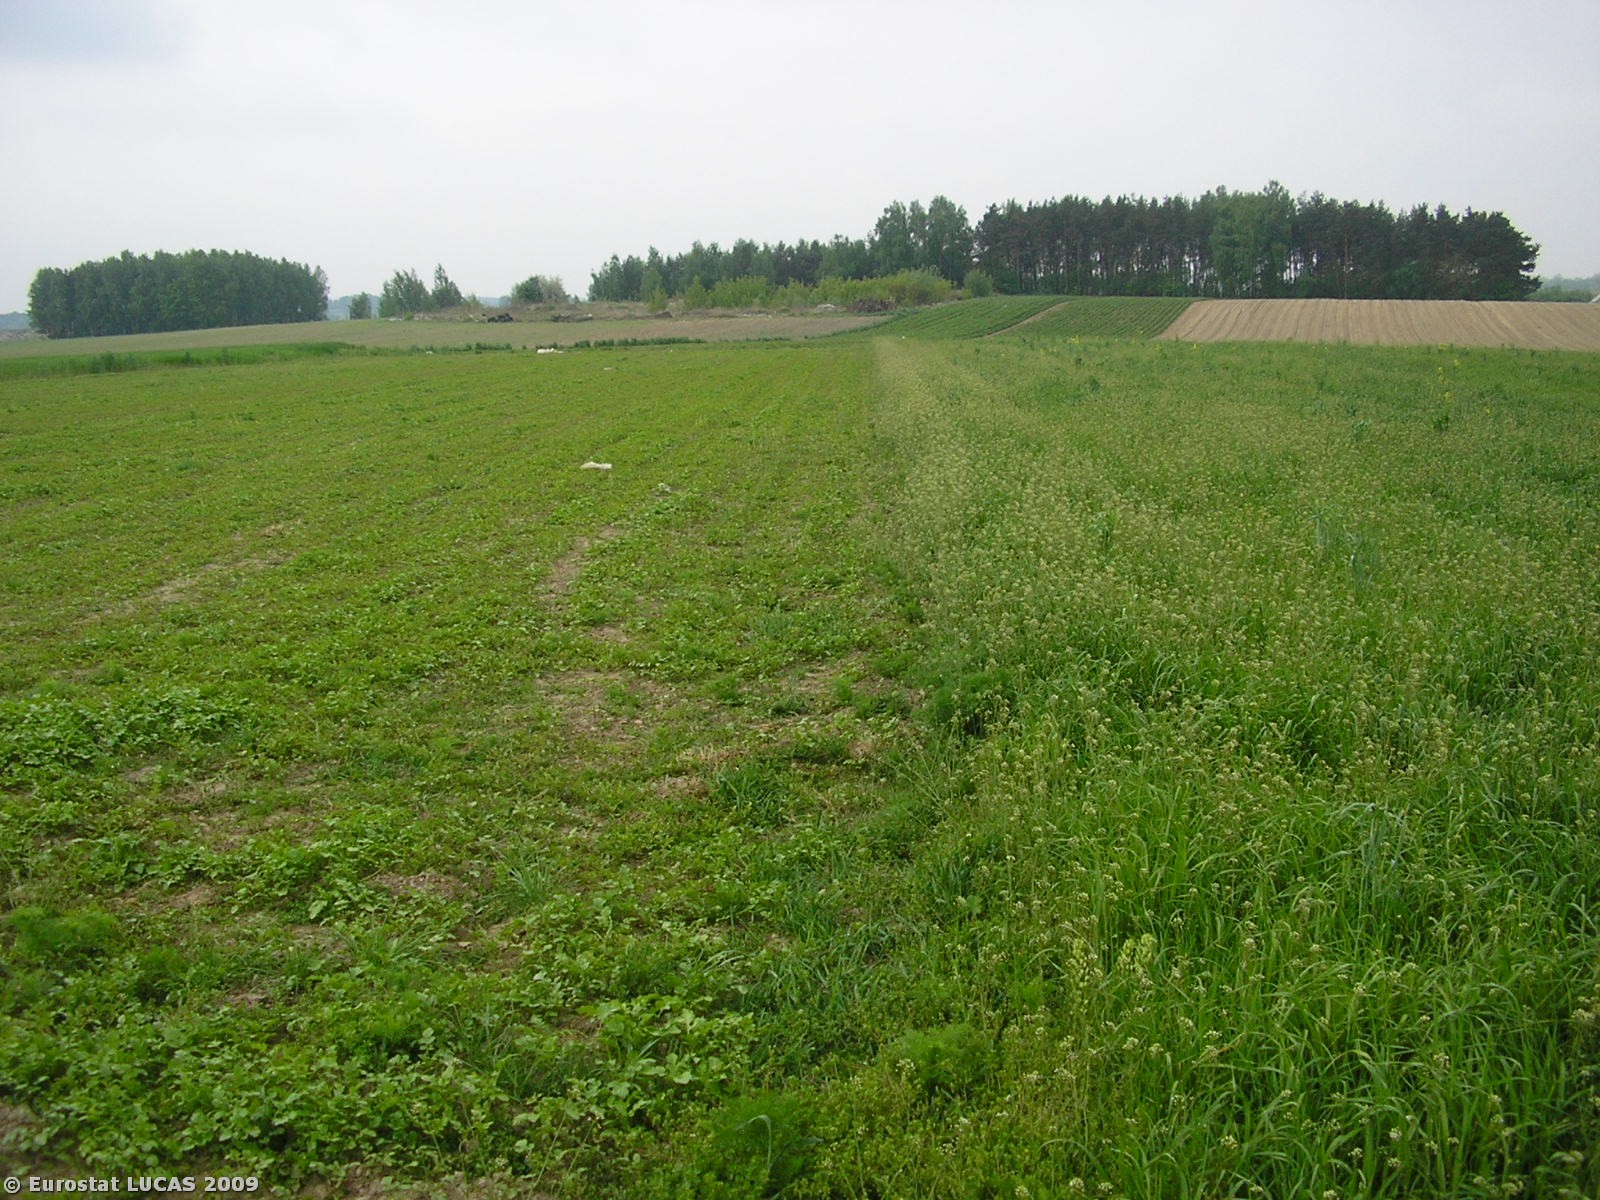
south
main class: Cropland
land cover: Lucerne
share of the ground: > 75 %
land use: Agriculture (excluding fallow land and kitchen gardens)
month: June
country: PL
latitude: 52.4901
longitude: 20.3009
